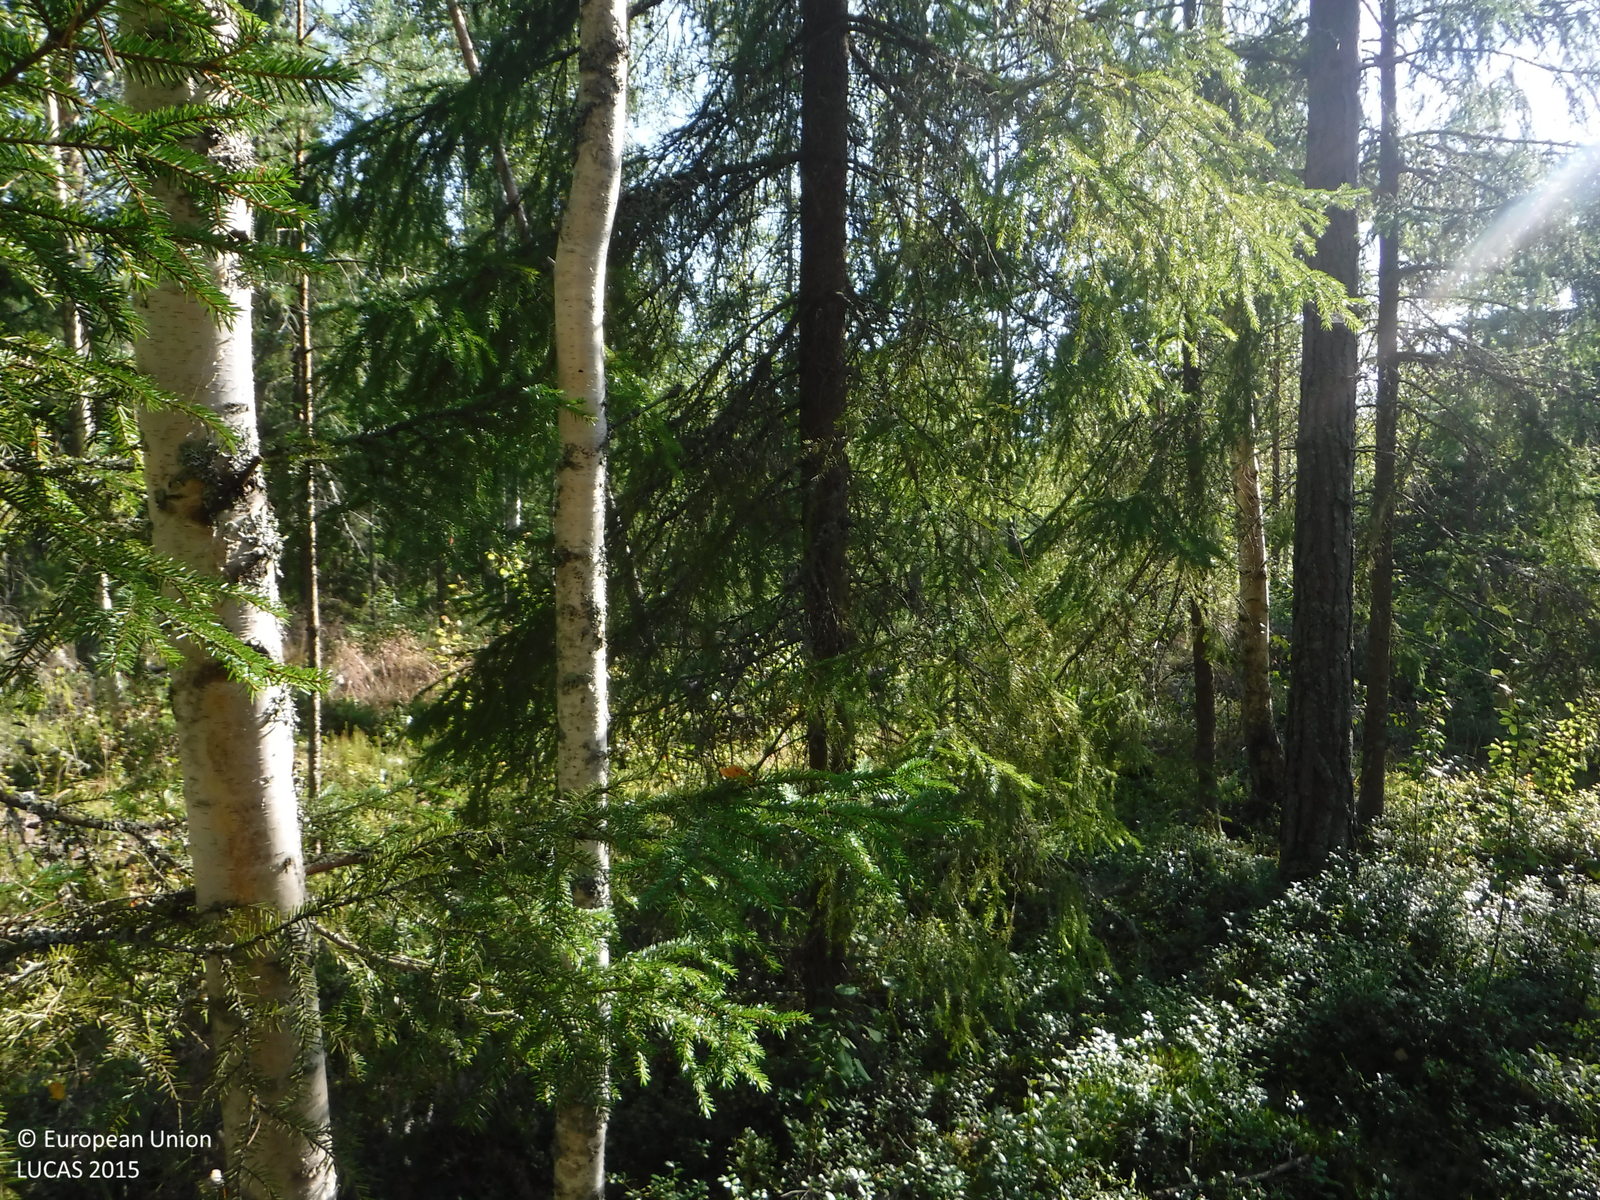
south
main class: Woodland
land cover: Pine dominated mixed woodland
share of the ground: 25 - 50 %
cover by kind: shrubs 55 %, coniferous forest trees 30 %, broadleaved forest trees 10 %, lichens and mosses 5 %
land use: Forestry
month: August
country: FI
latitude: 61.0558
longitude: 21.5195
